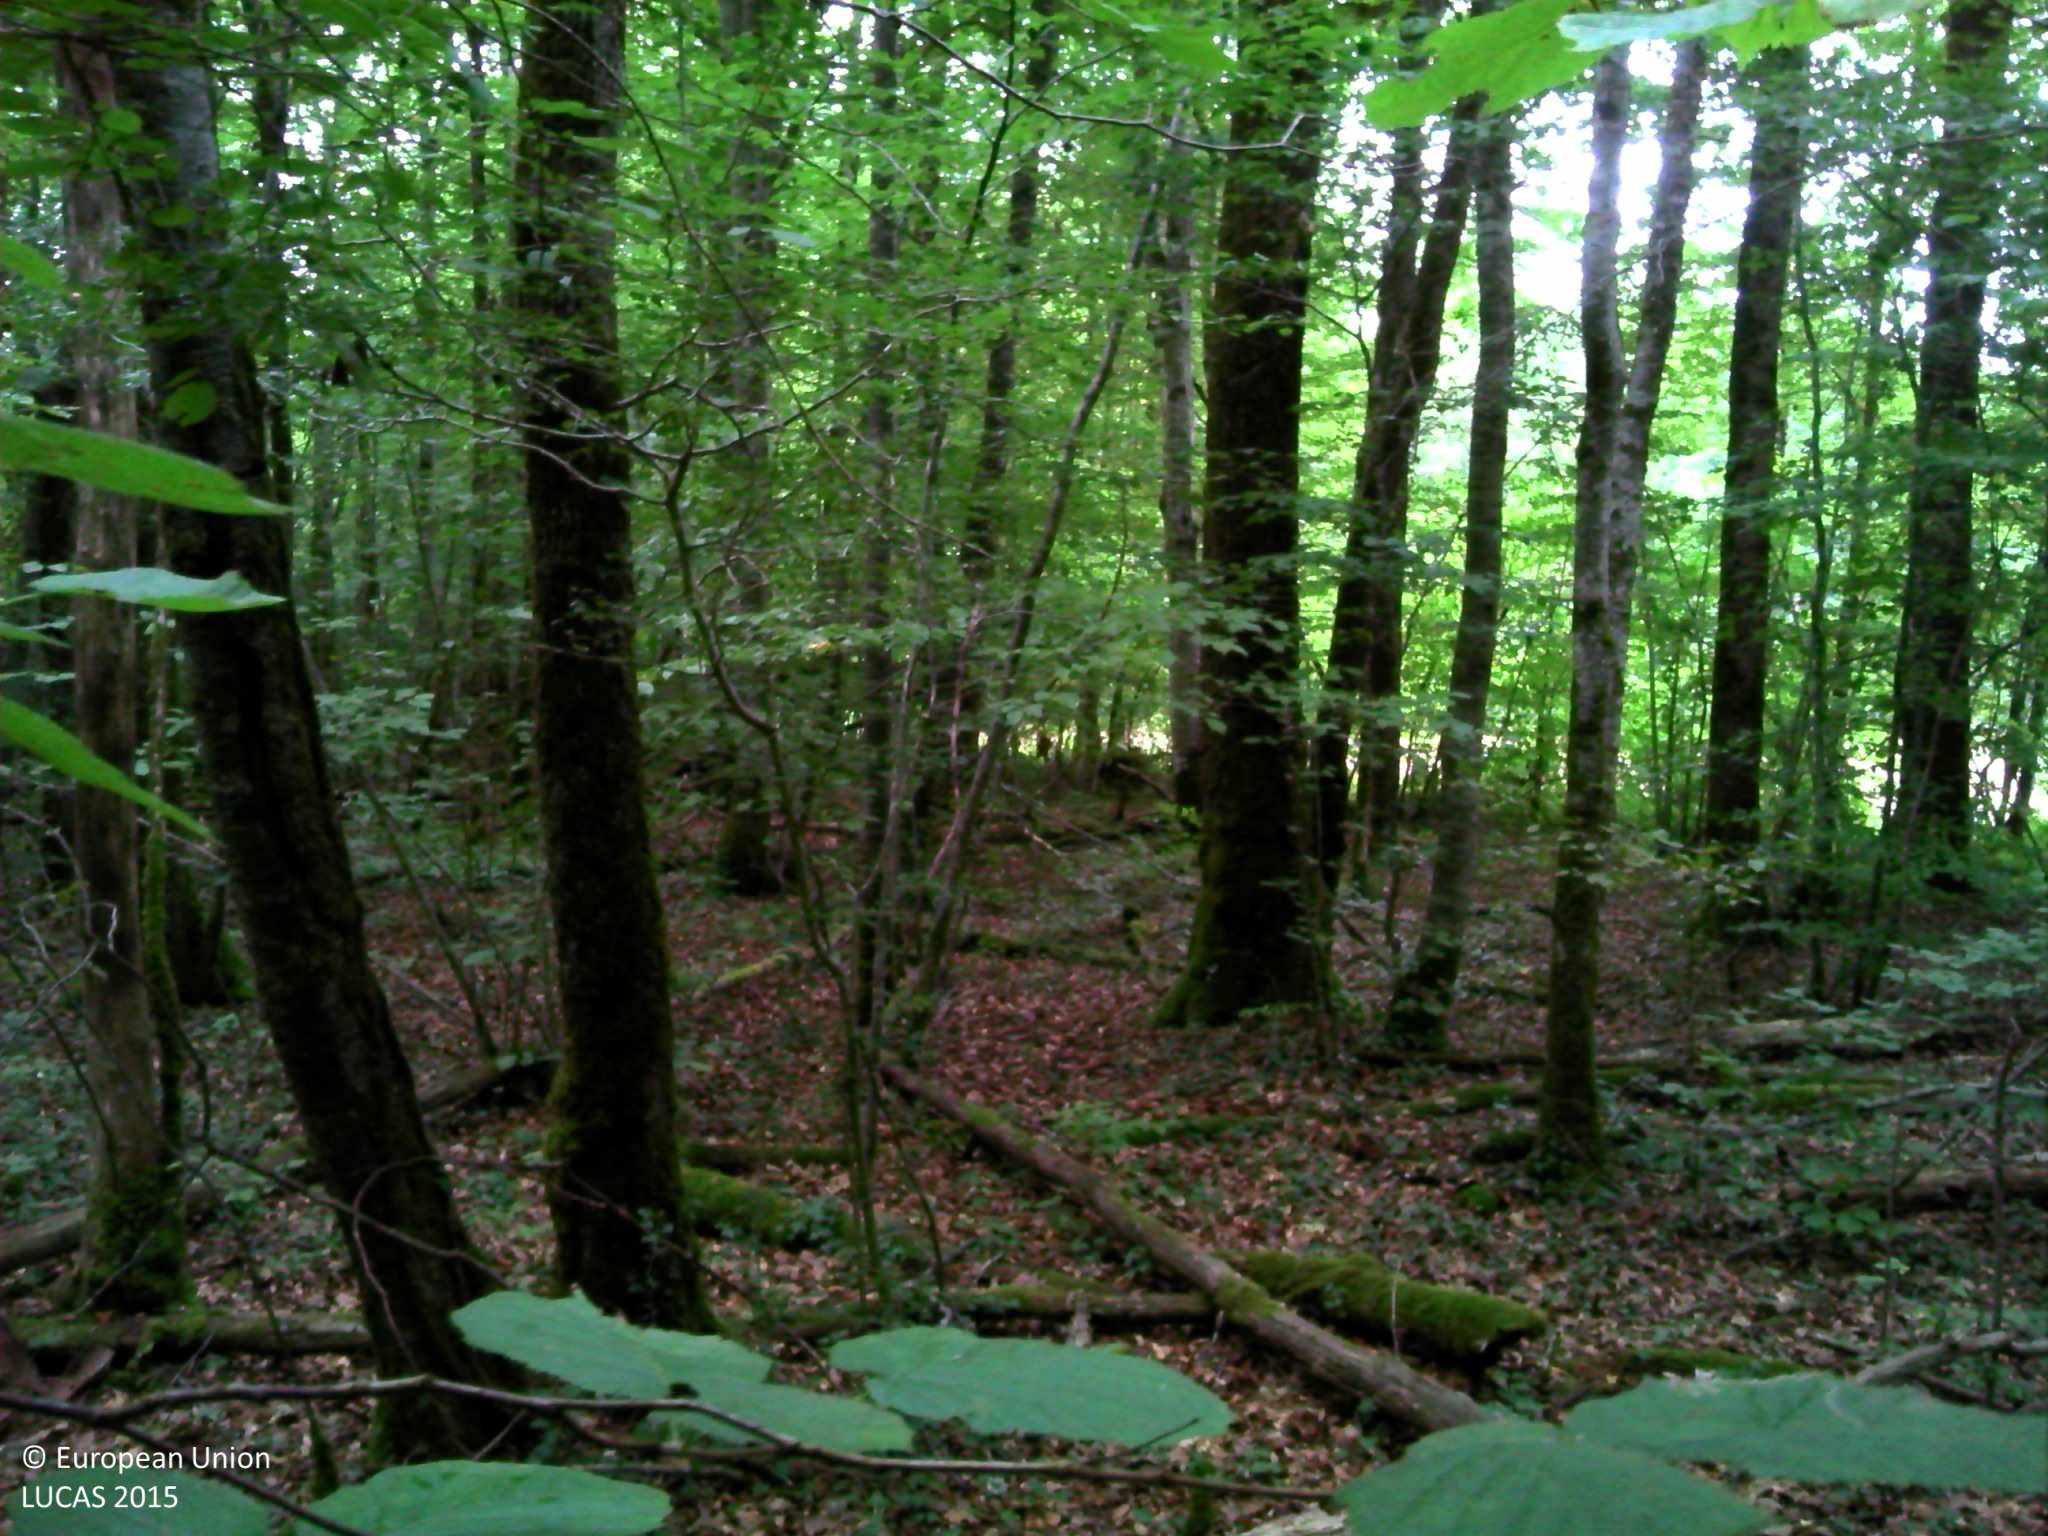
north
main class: Woodland
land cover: Broadleaved woodland
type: mesophytic deciduous forest
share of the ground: > 75 %
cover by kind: broadleaved forest trees 85 %, shrubs 5 %, herbaceous plants 5 %, lichens and mosses 5 %
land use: Forestry
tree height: > 5 m
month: August
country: FR
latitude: 47.8757
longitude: 4.2617
